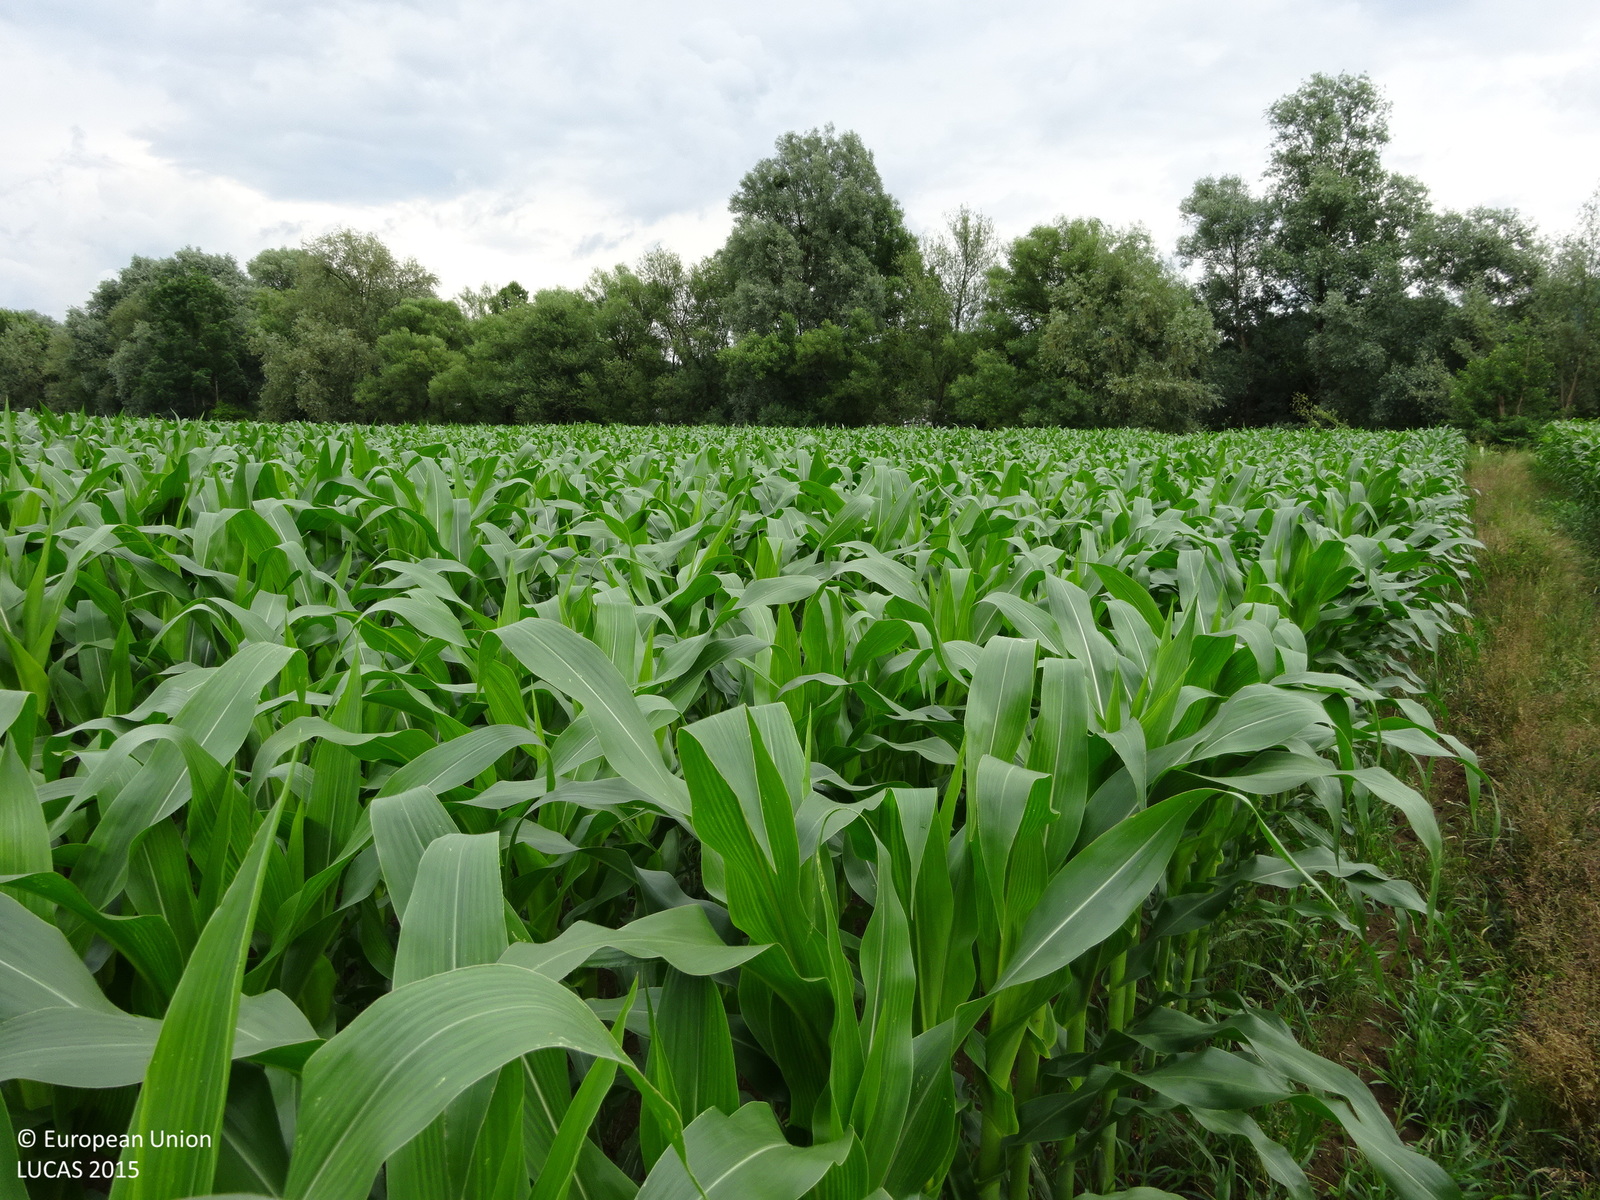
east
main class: Cropland
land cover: Maize
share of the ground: > 75 %
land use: Agriculture (excluding fallow land and kitchen gardens)
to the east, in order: Maize; Grassland without tree/shrub cover; Broadleaved woodland; Inland fresh running water; Broadleaved woodland; Grass margins; Paved roads, cycling and walking lanes; Grass margins; Other fibre and oleaginous crops
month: June
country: AT
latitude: 46.7367
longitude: 15.4302
